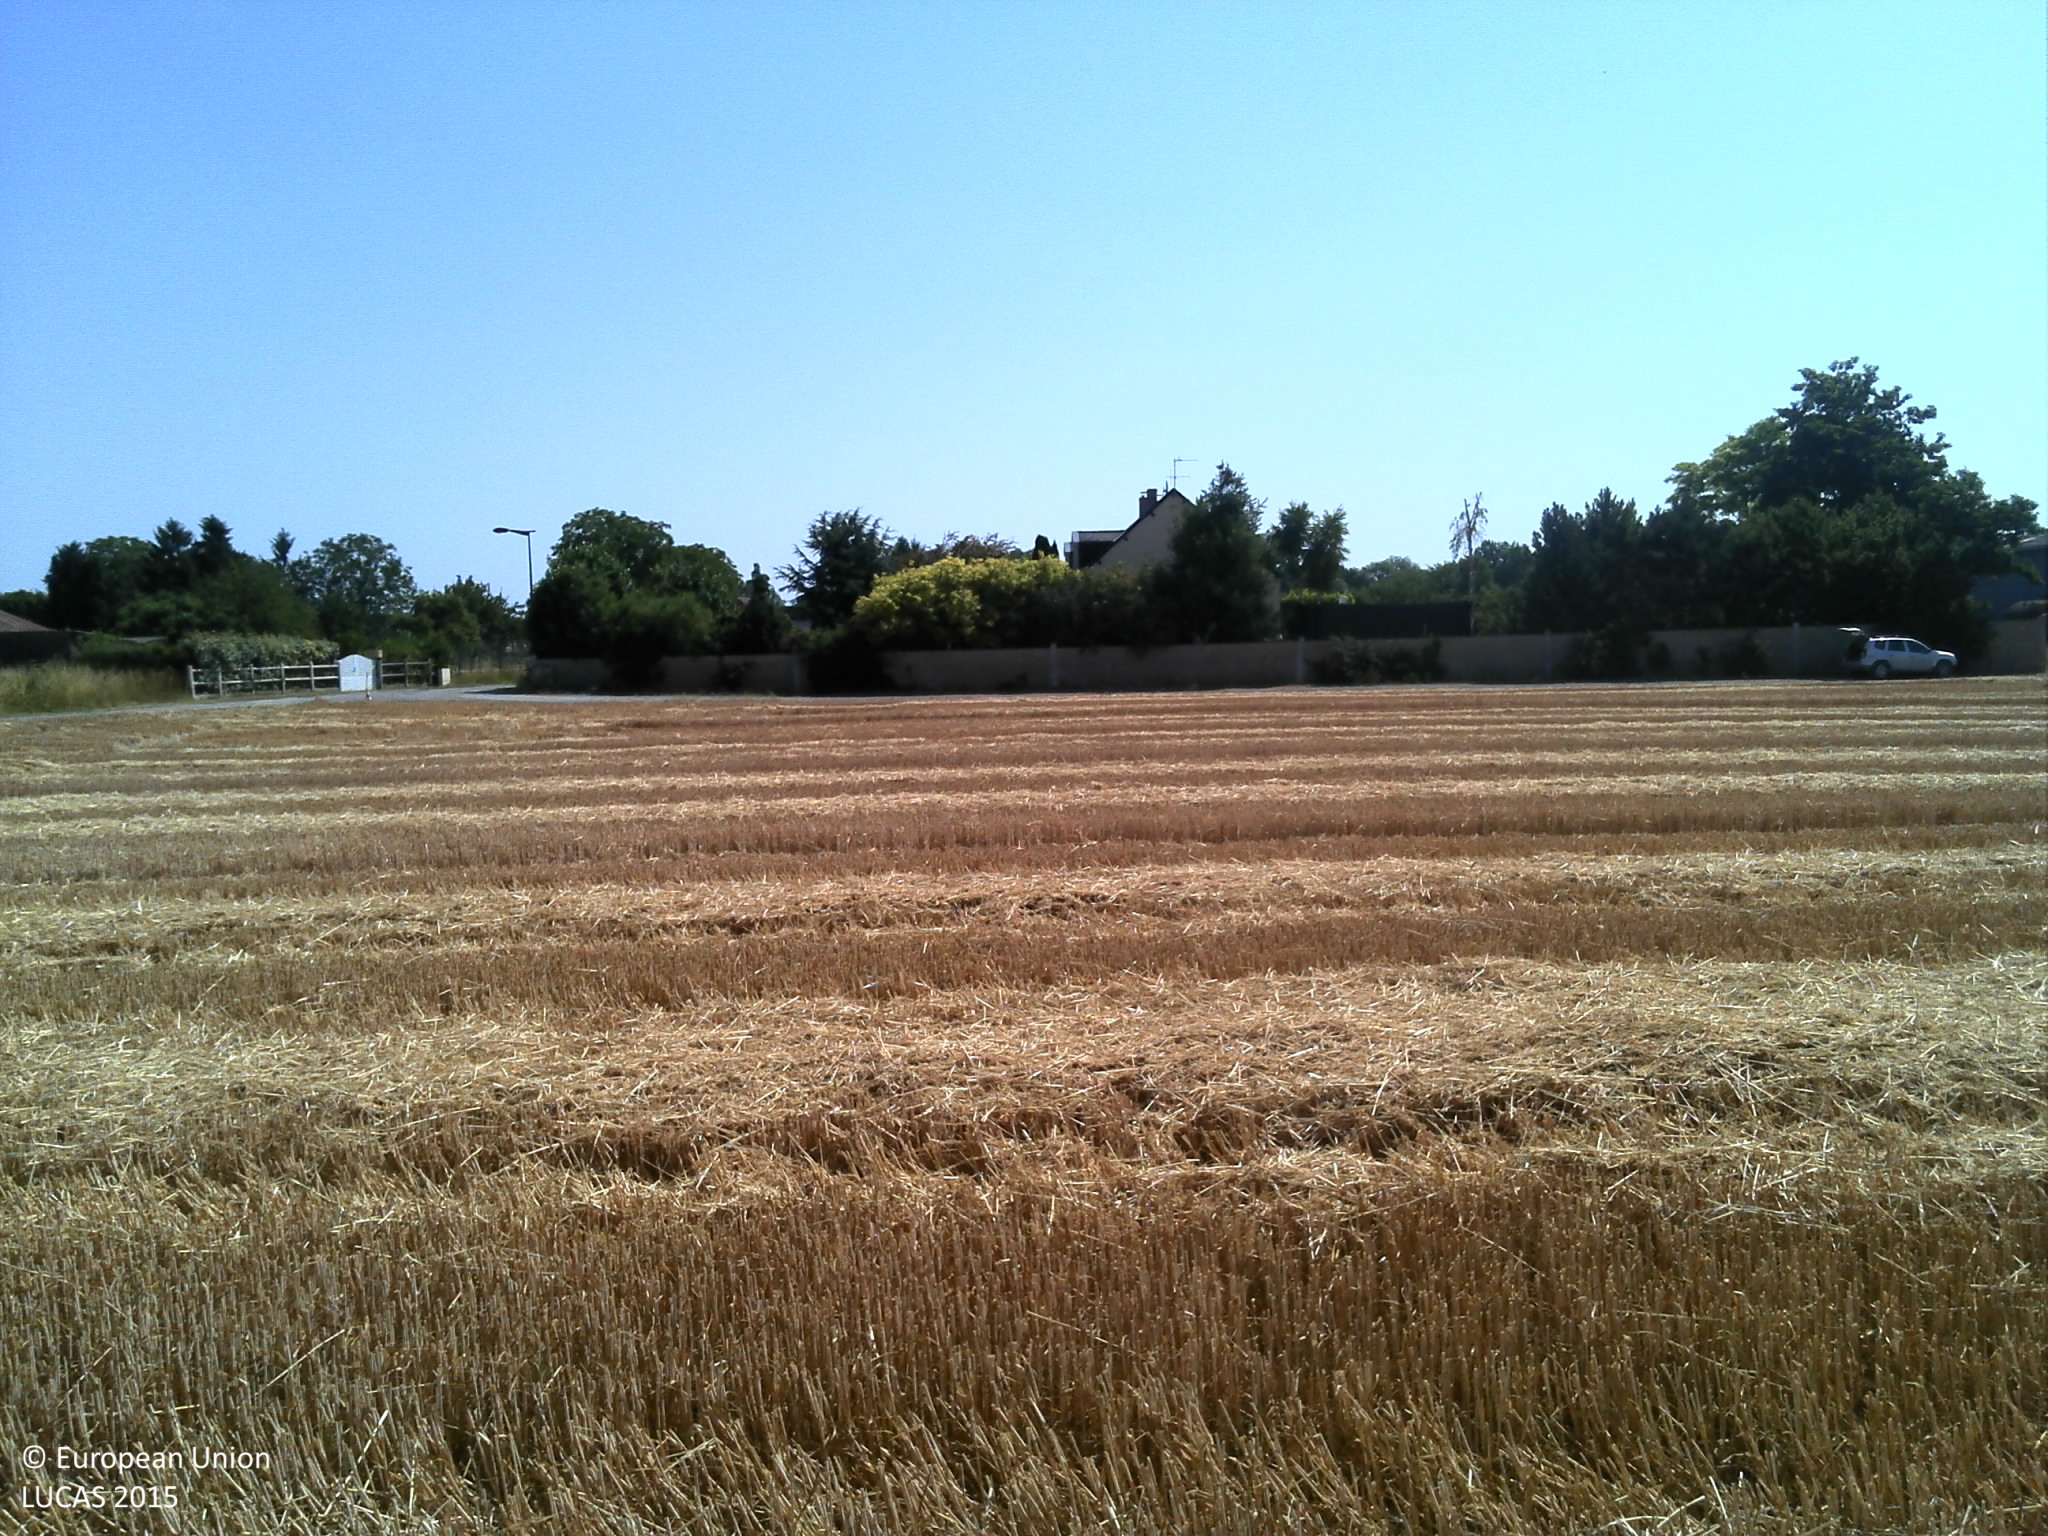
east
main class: Grassland
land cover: Grassland with sparse tree/shrub cover
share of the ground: > 75 %
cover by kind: herbaceous plants 95 %, broadleaved forest trees 5 %
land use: Residential
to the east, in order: Grassland with sparse tree/shrub cover; Common wheat; Paved roads, cycling and walking lanes; Managed hedges; Grassland with sparse tree/shrub cover; Managed hedges; Paved roads, cycling and walking lanes; Grassland with sparse tree/shrub cover; Fences; Grassland with sparse tree/shrub cover; Artificial constructions in urban areas; Grassland with sparse tree/shrub cover
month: July
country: FR
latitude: 49.4532
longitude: 4.0770
